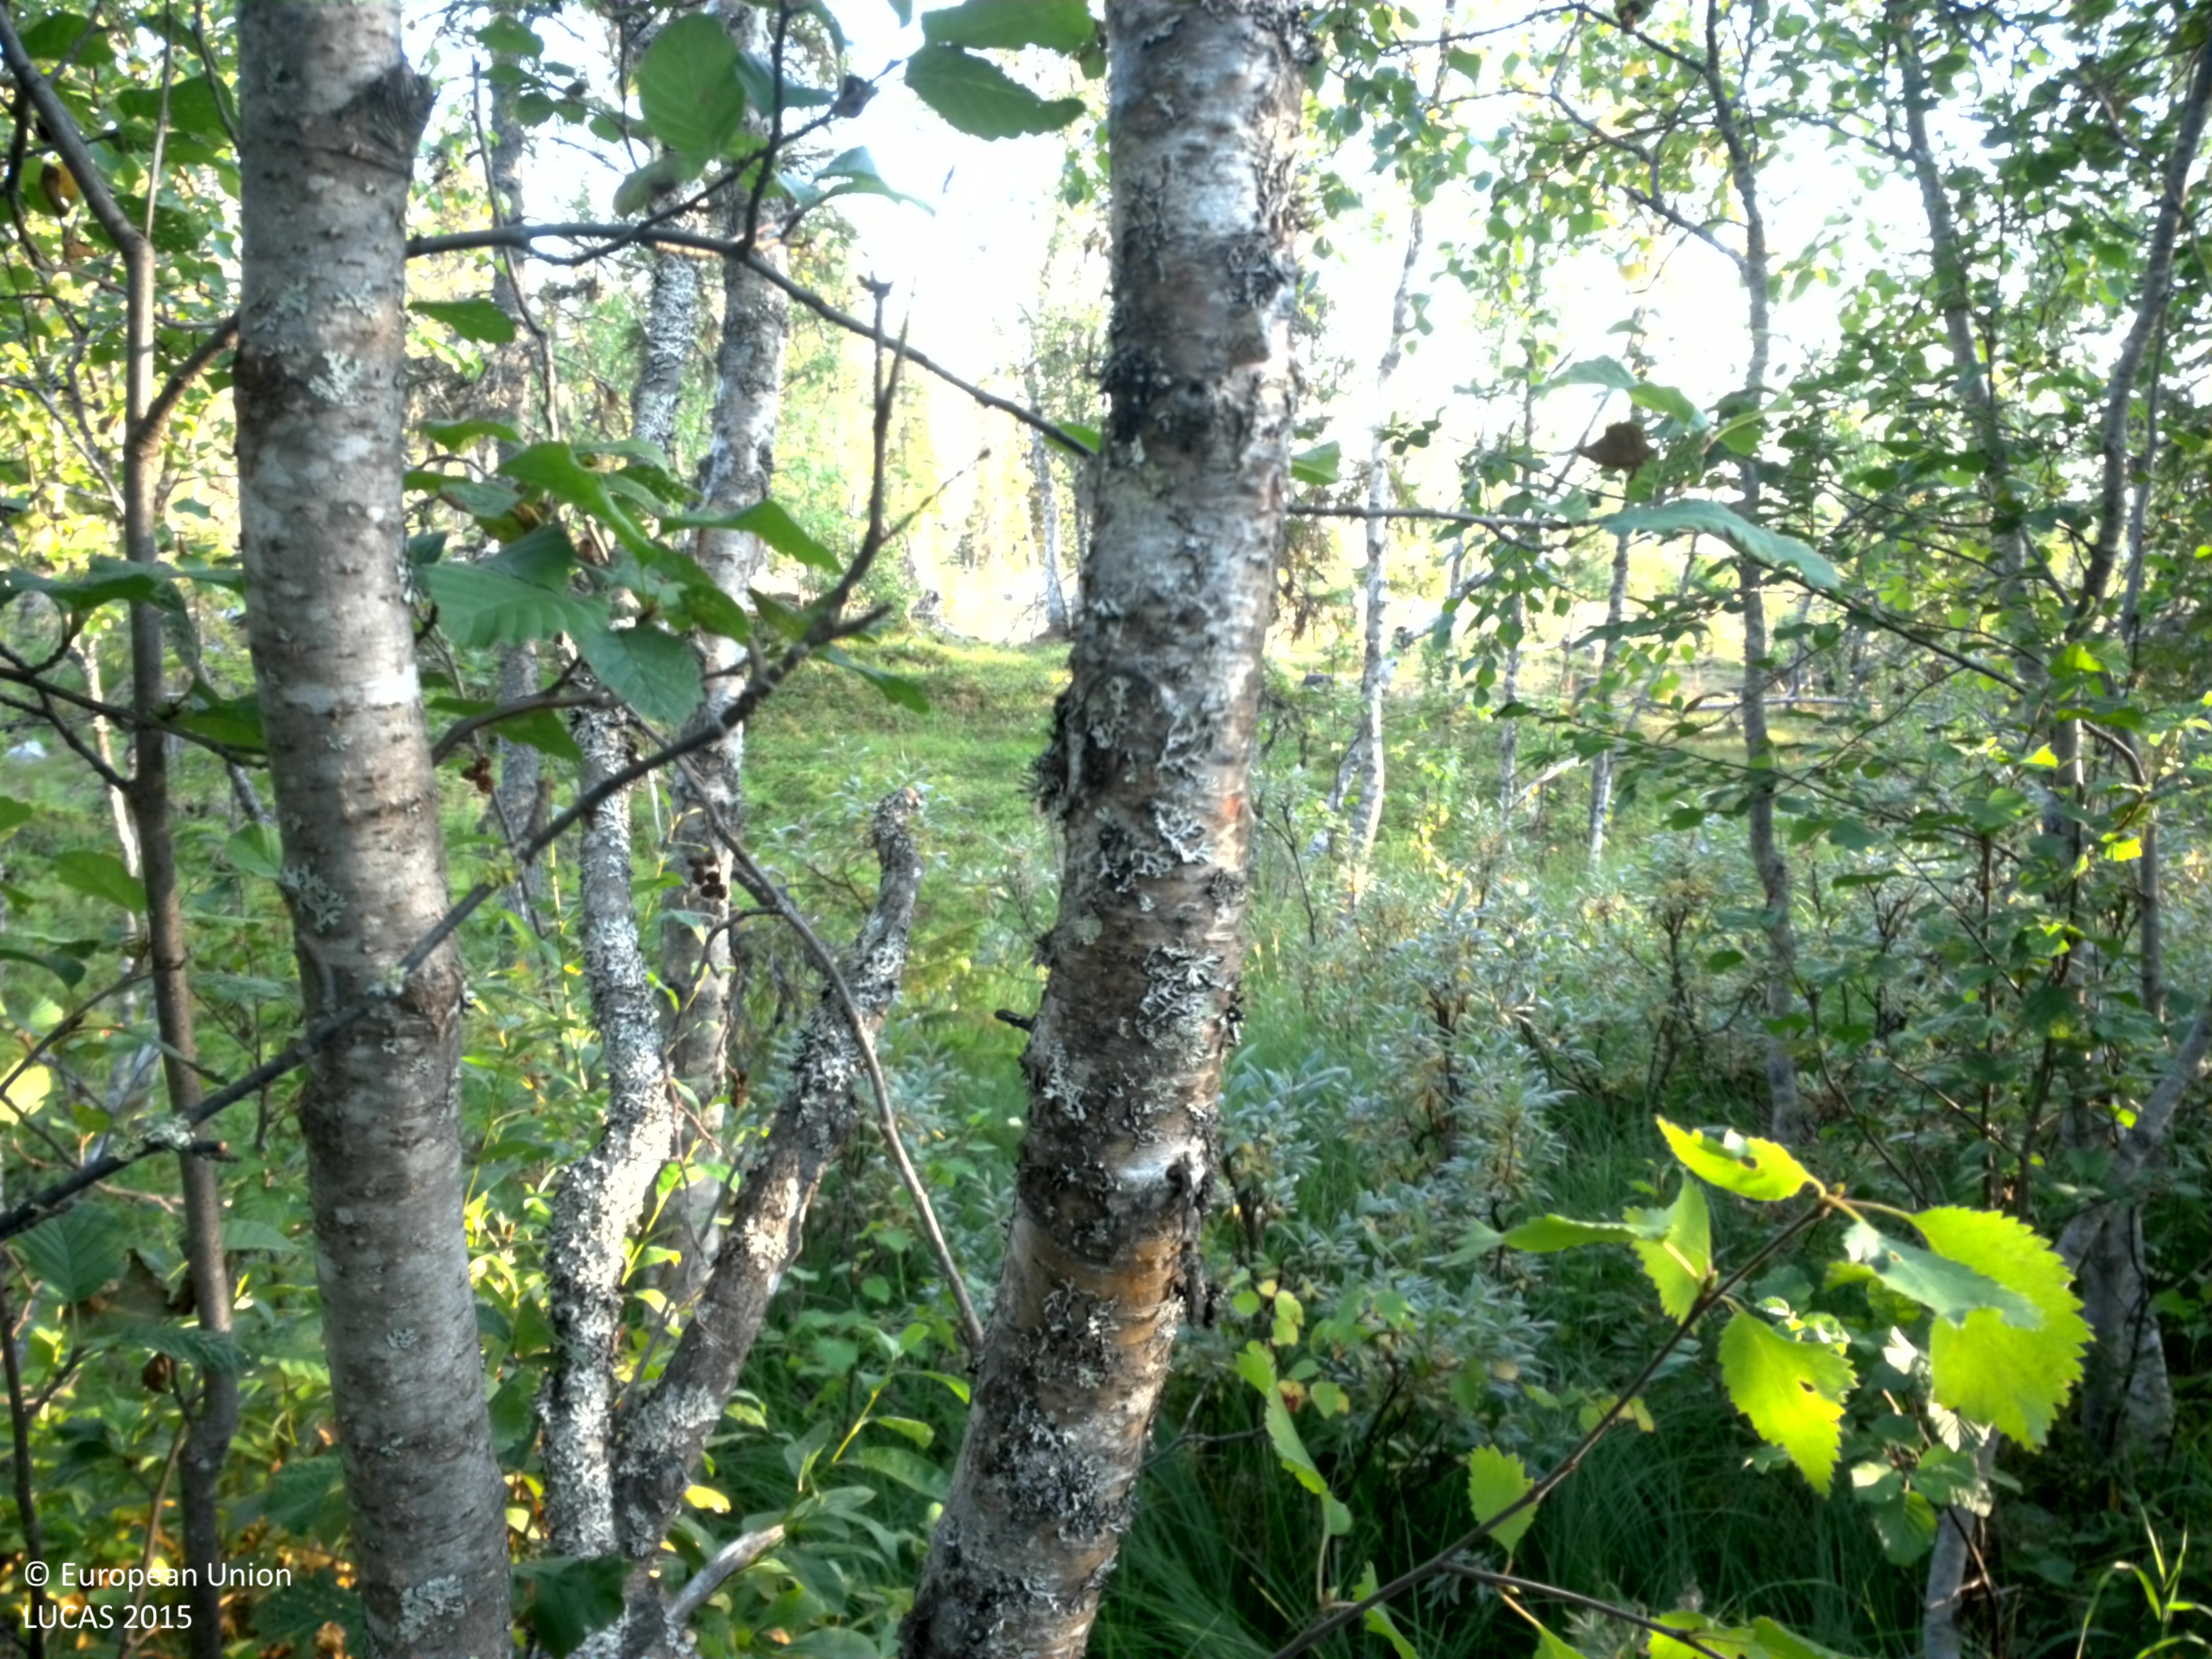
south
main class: Woodland
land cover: Broadleaved woodland
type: non-riverine alder, birch or aspen forest
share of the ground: 50 - 75 %
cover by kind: broadleaved forest trees 60 %, herbaceous plants 25 %, shrubs 10 %, coniferous forest trees 5 %
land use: Semi-natural and natural areas not in use
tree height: > 5 m
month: August
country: SE
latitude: 64.7835
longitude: 16.6765
